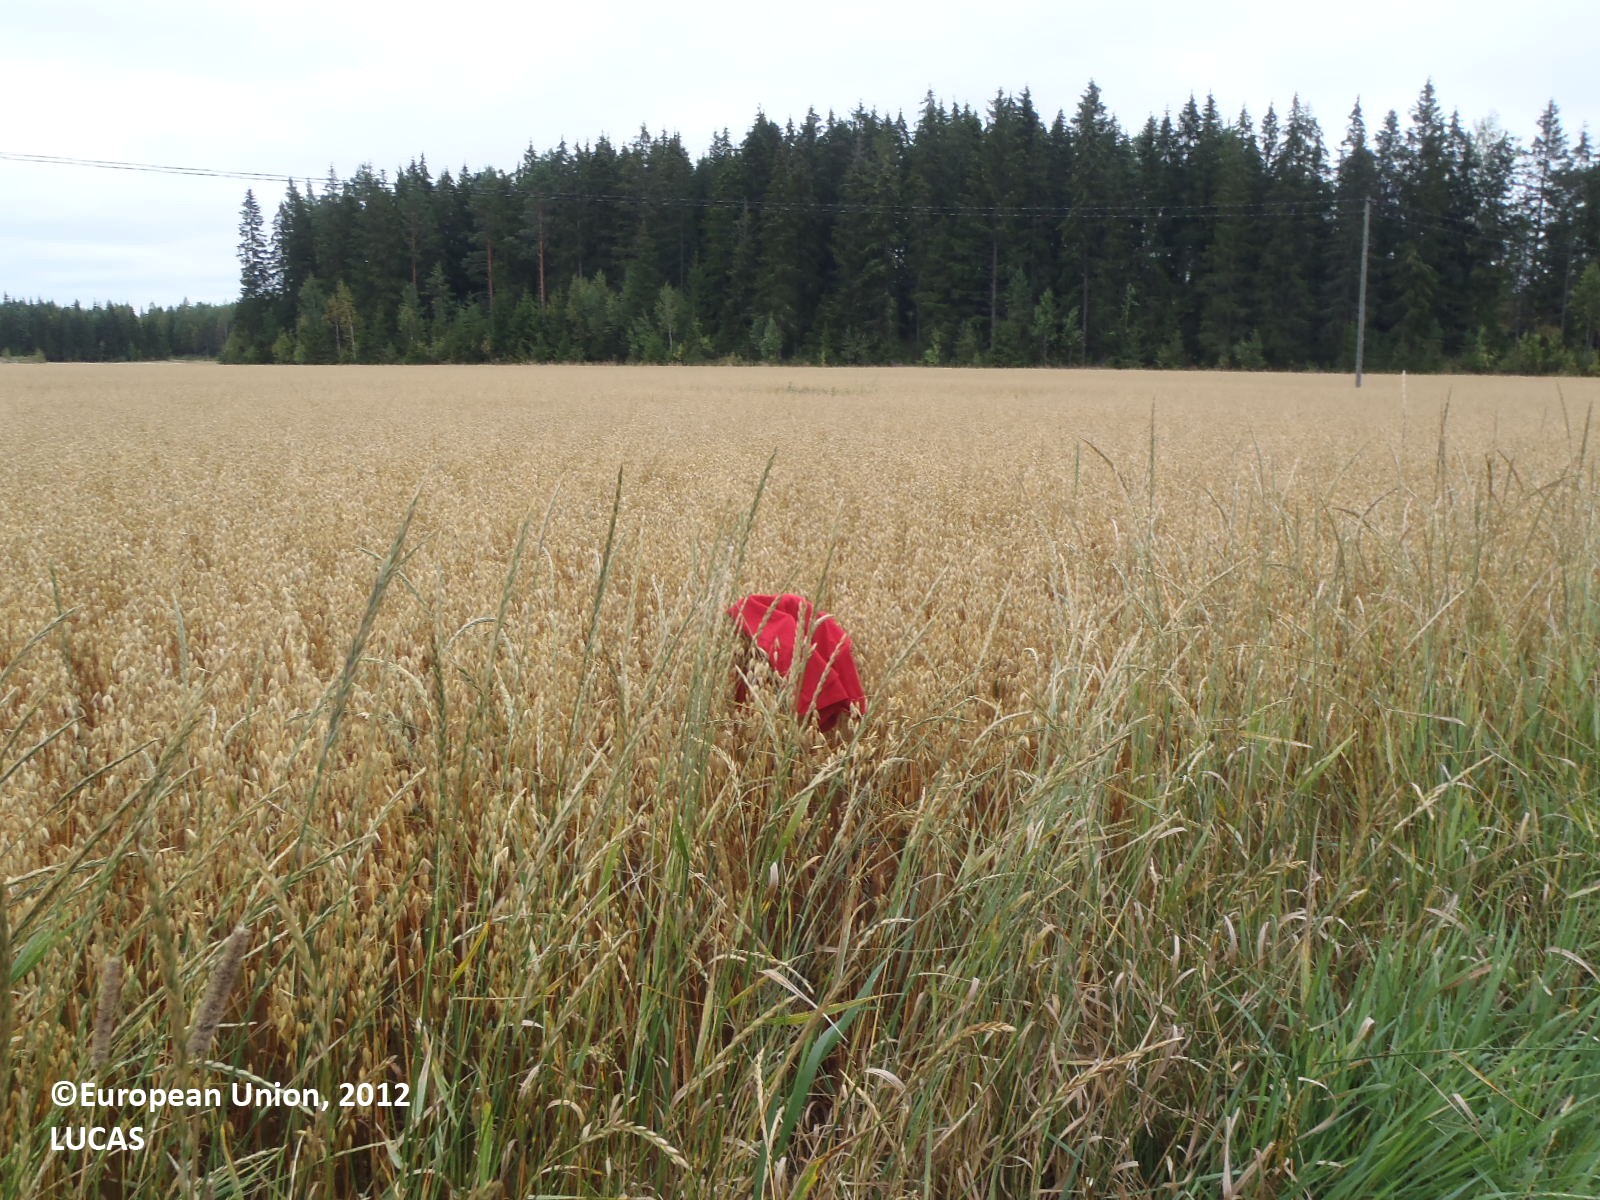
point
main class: Cropland
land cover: Oats
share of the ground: > 75 %
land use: Agriculture (excluding fallow land and kitchen gardens)
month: August
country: FI
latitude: 60.7631
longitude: 21.9731
